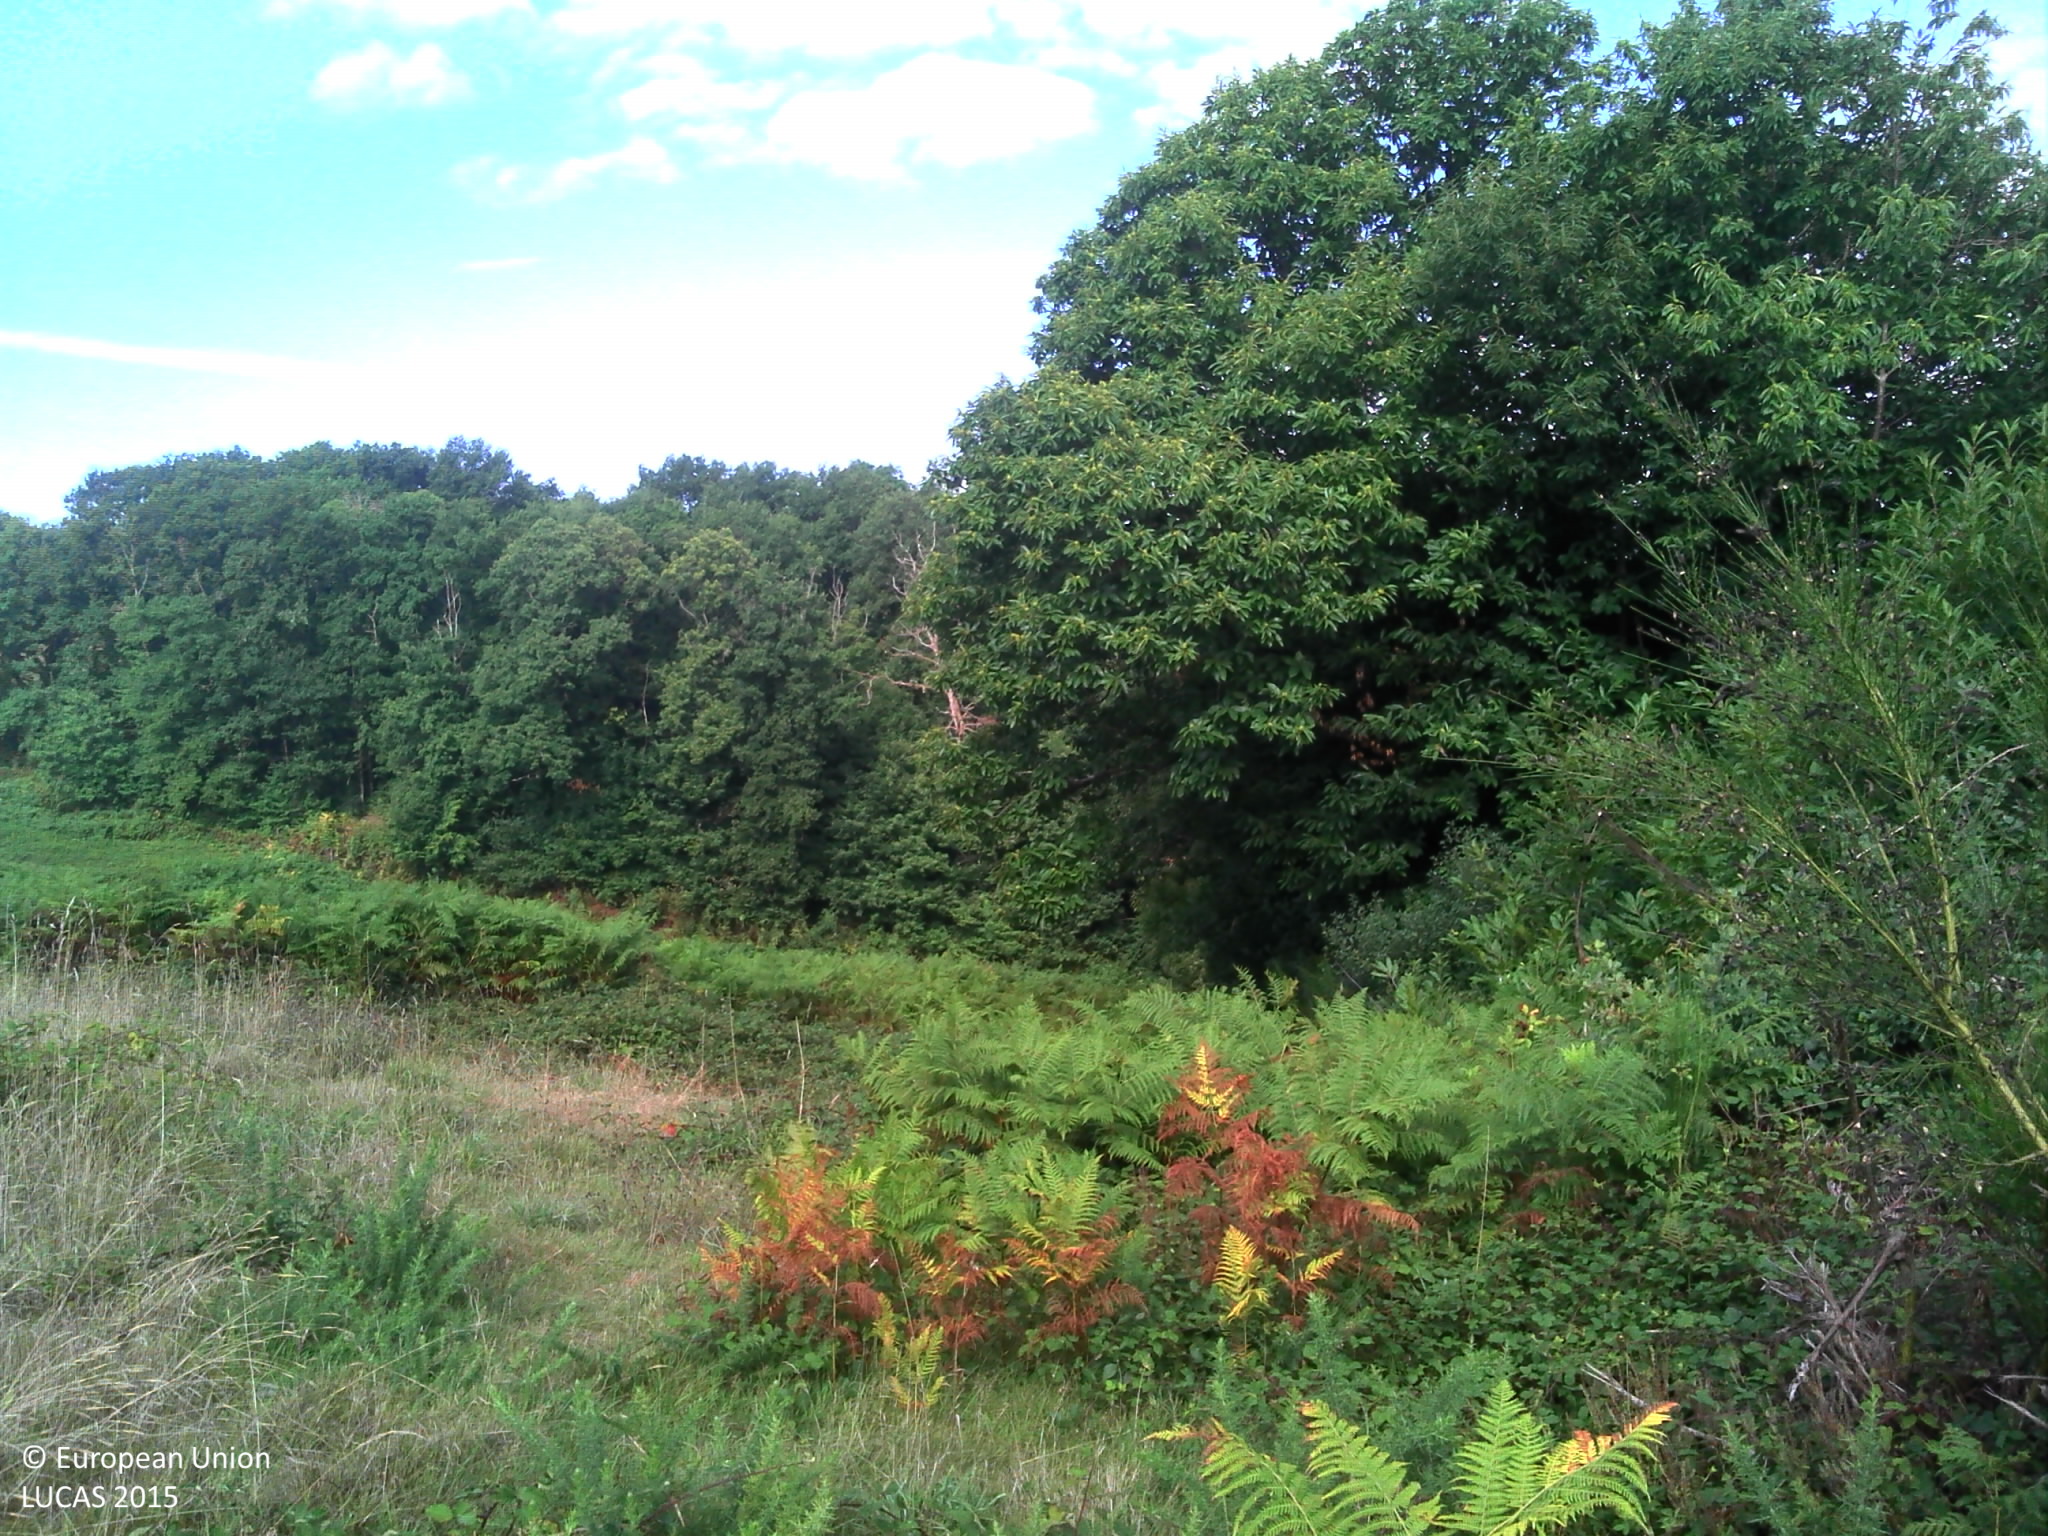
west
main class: Grassland
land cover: Spontaneously vegetated surfaces
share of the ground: > 75 %
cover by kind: herbaceous plants 95 %, shrubs 5 %
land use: Semi-natural and natural areas not in use
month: August
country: FR
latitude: 46.2086
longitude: 1.2403
